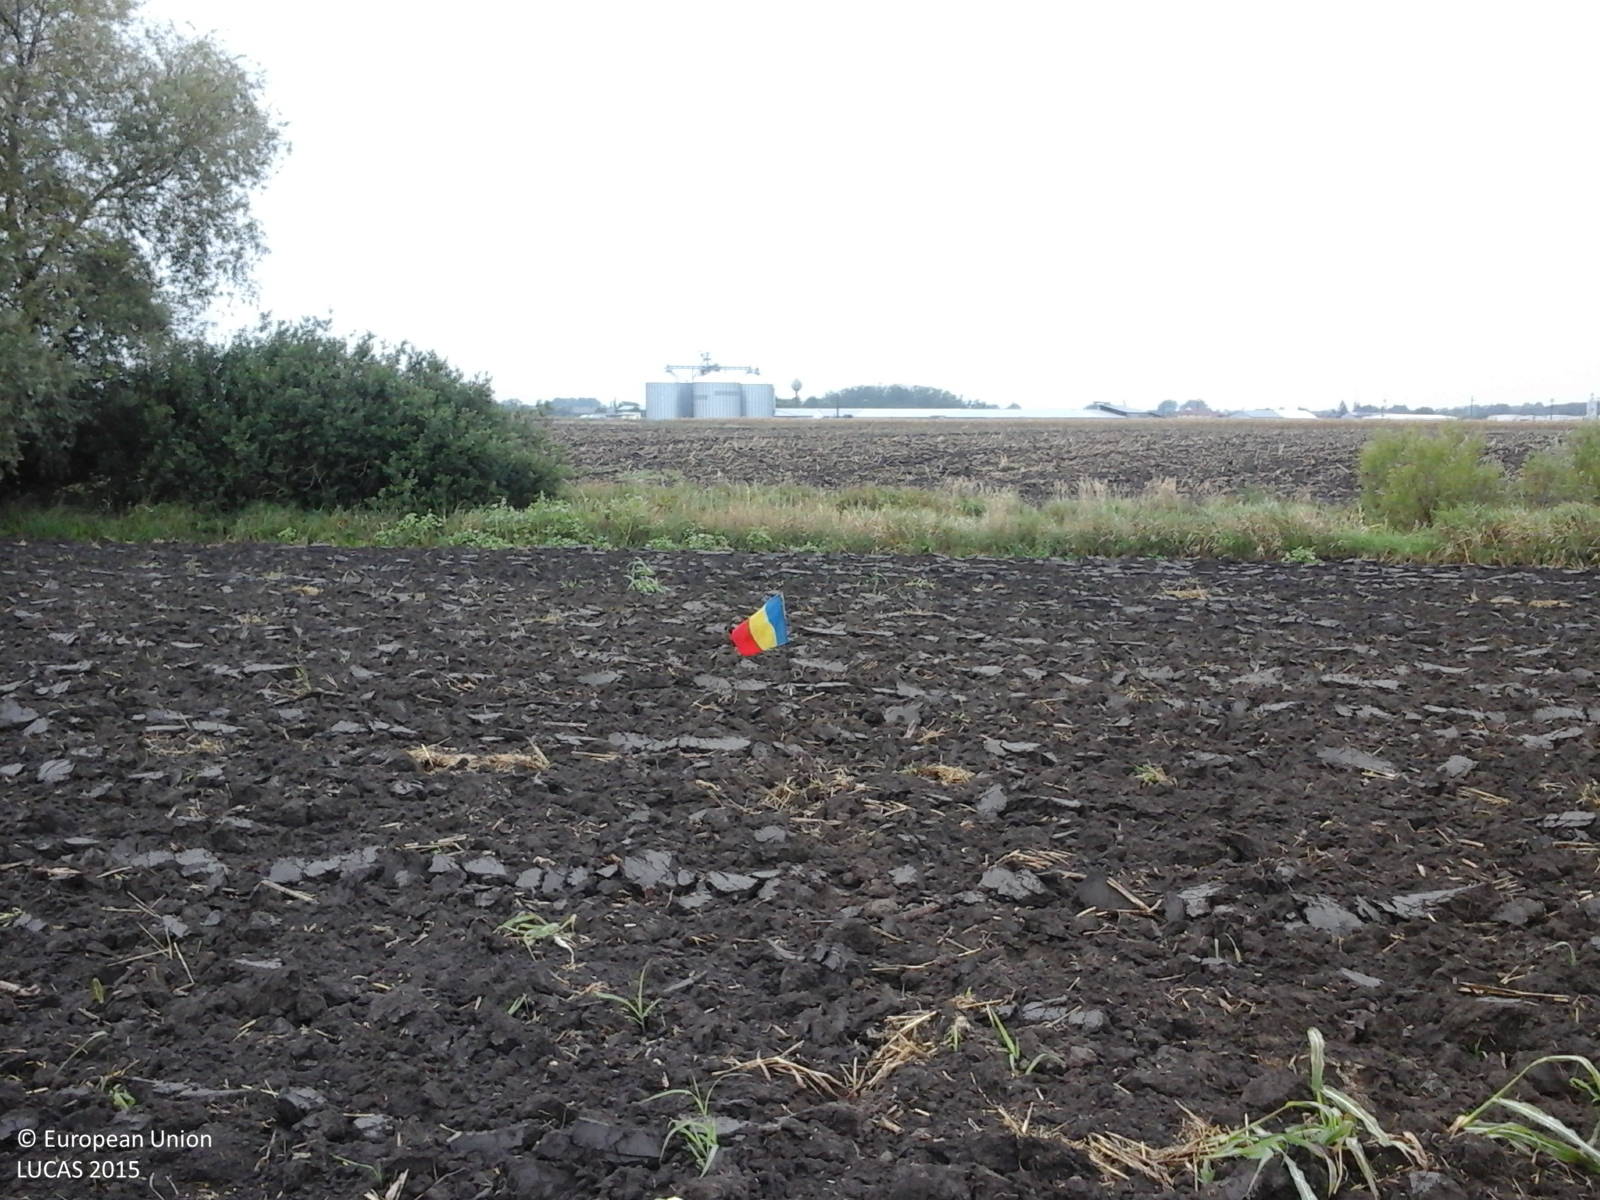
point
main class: Cropland
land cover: Common wheat
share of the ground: < 10 %
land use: Agriculture (excluding fallow land and kitchen gardens)
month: September
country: RO
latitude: 47.4533
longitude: 22.1882
